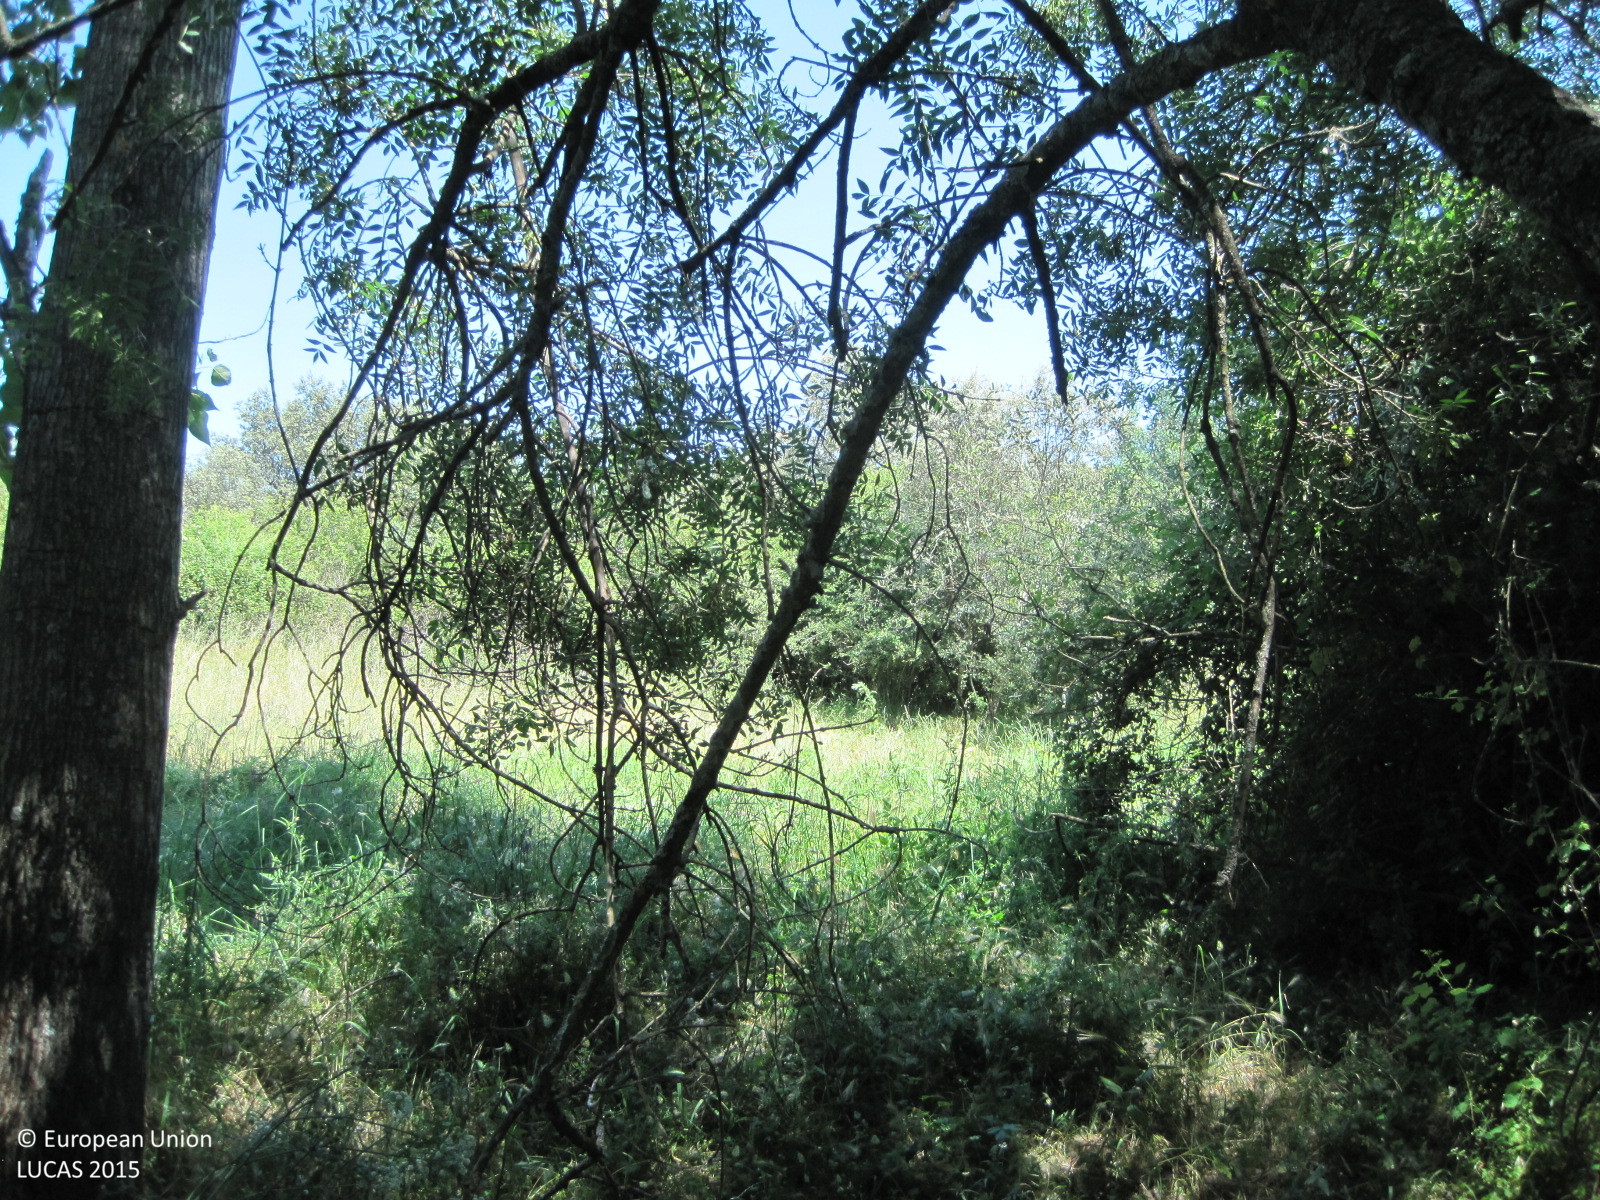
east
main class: Woodland
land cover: Broadleaved woodland
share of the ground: > 75 %
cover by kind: broadleaved forest trees 100 %
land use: Semi-natural and natural areas not in use
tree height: > 5 m
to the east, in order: Broadleaved woodland; Rivers and streams; Shruby margins; Grassland without tree/shrub cover; Abandoned hedges; Grass margins; Tracks; Grass margins; Fences; Broadleaved woodland
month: May
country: ES
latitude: 40.1429
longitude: -5.1864
